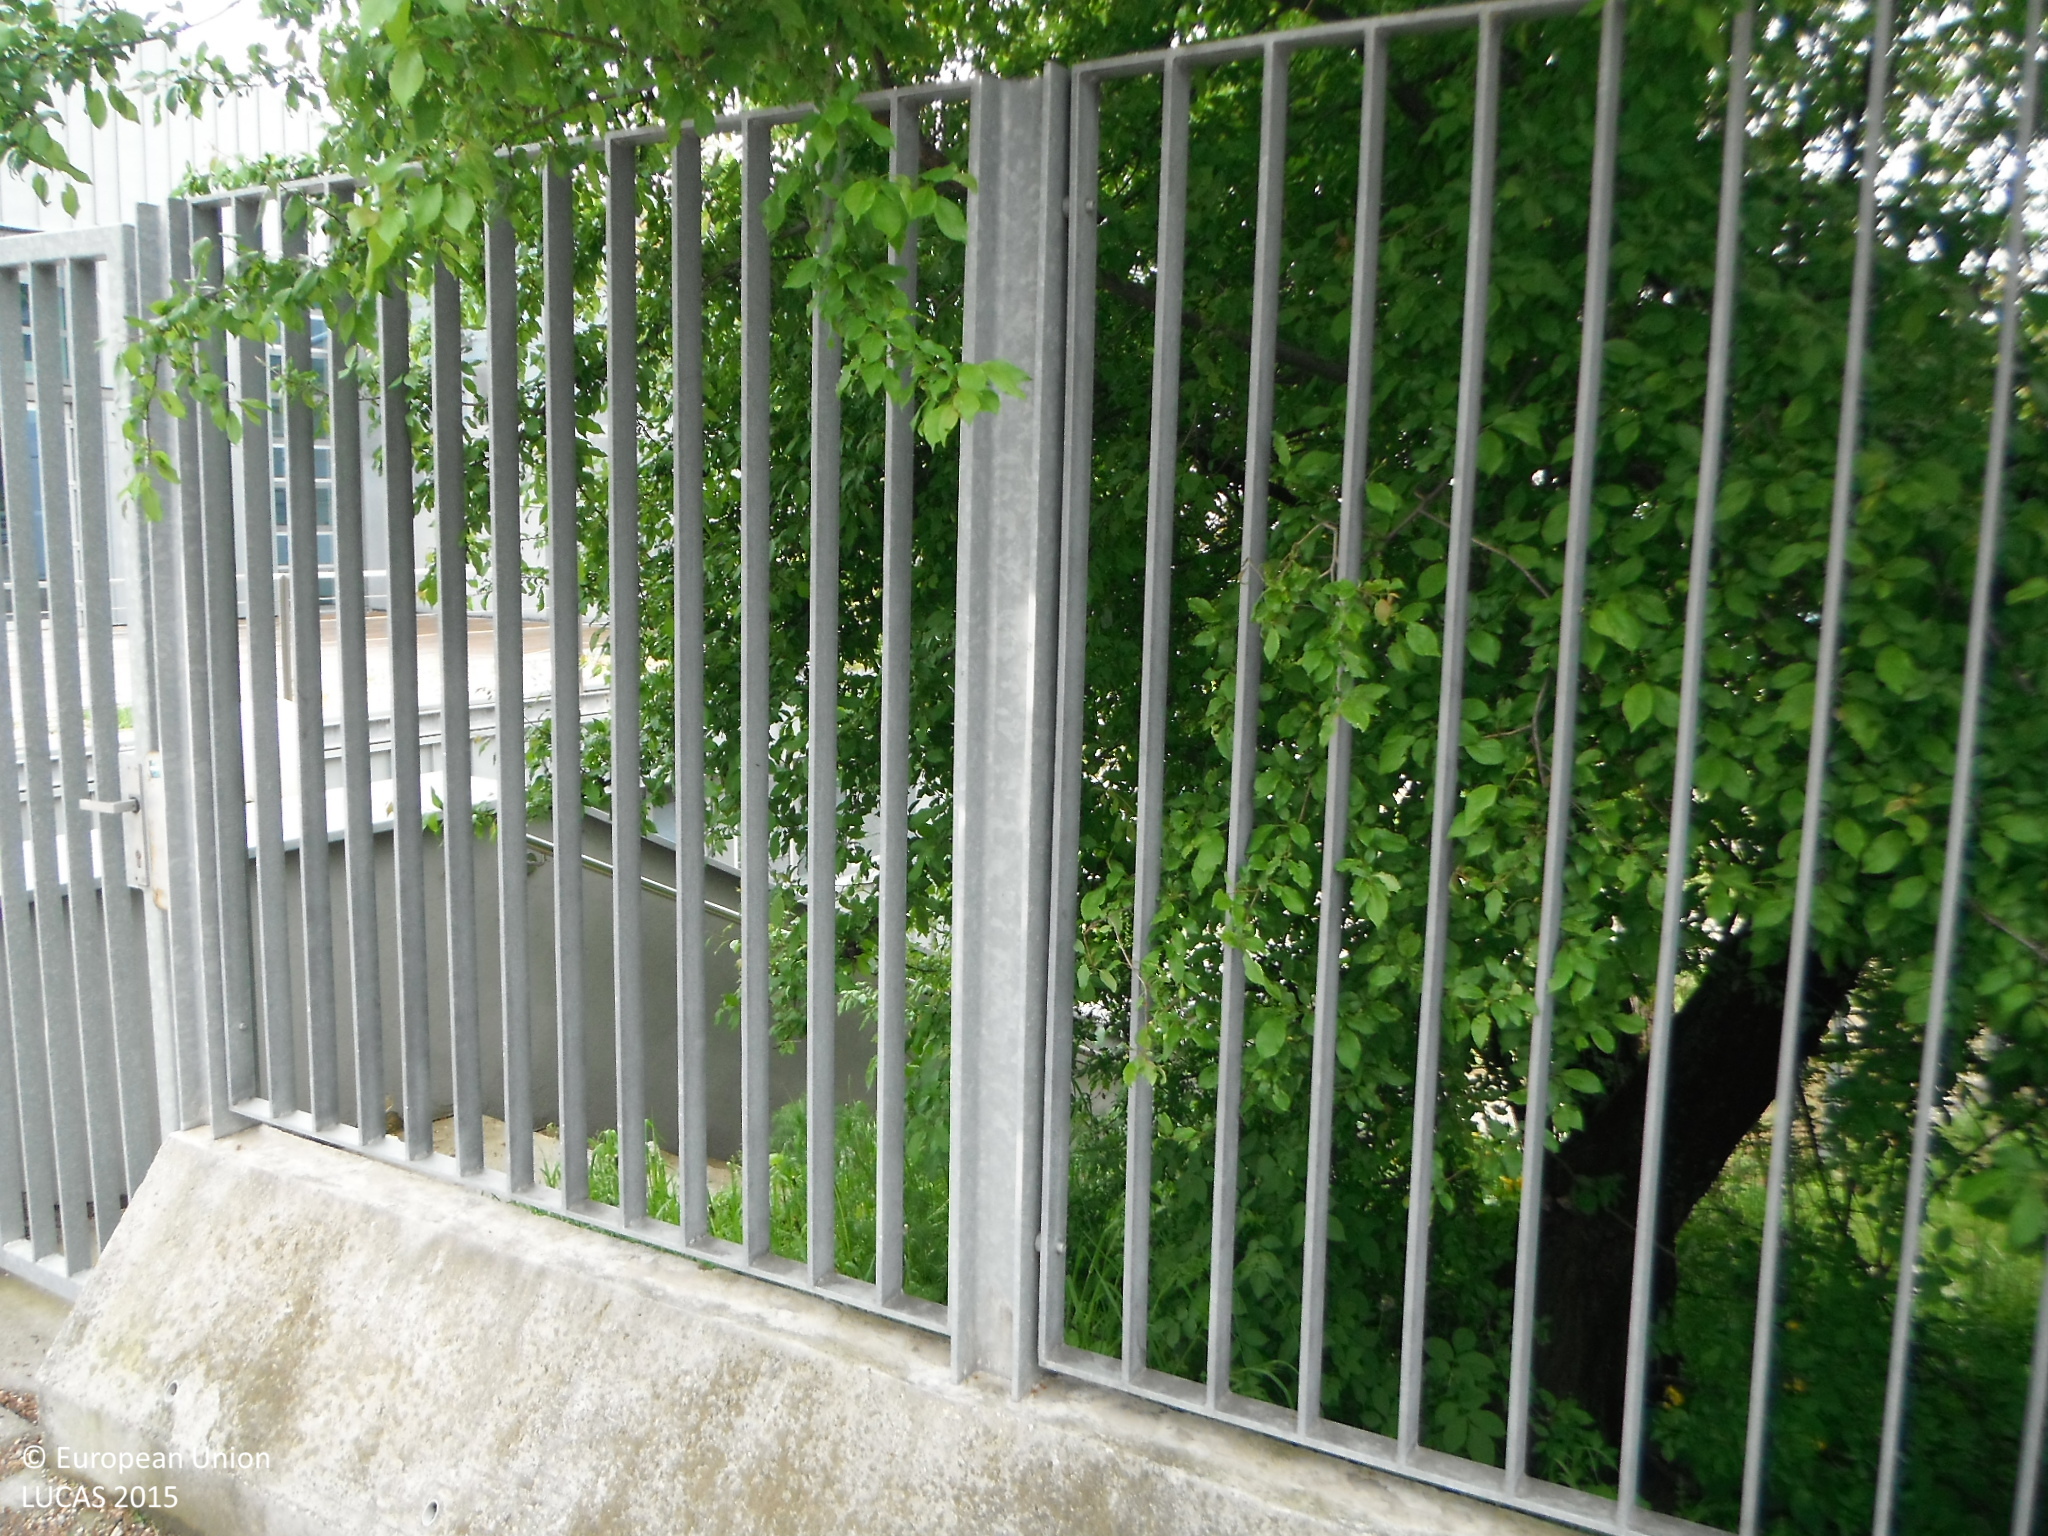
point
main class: Cropland
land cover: Other fruit trees and berries
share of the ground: > 75 %
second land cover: Grassland without tree/shrub cover
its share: > 75 %
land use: Kitchen garden
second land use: Amenities, museums, leisure
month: May
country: SK
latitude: 48.3235
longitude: 18.0924
